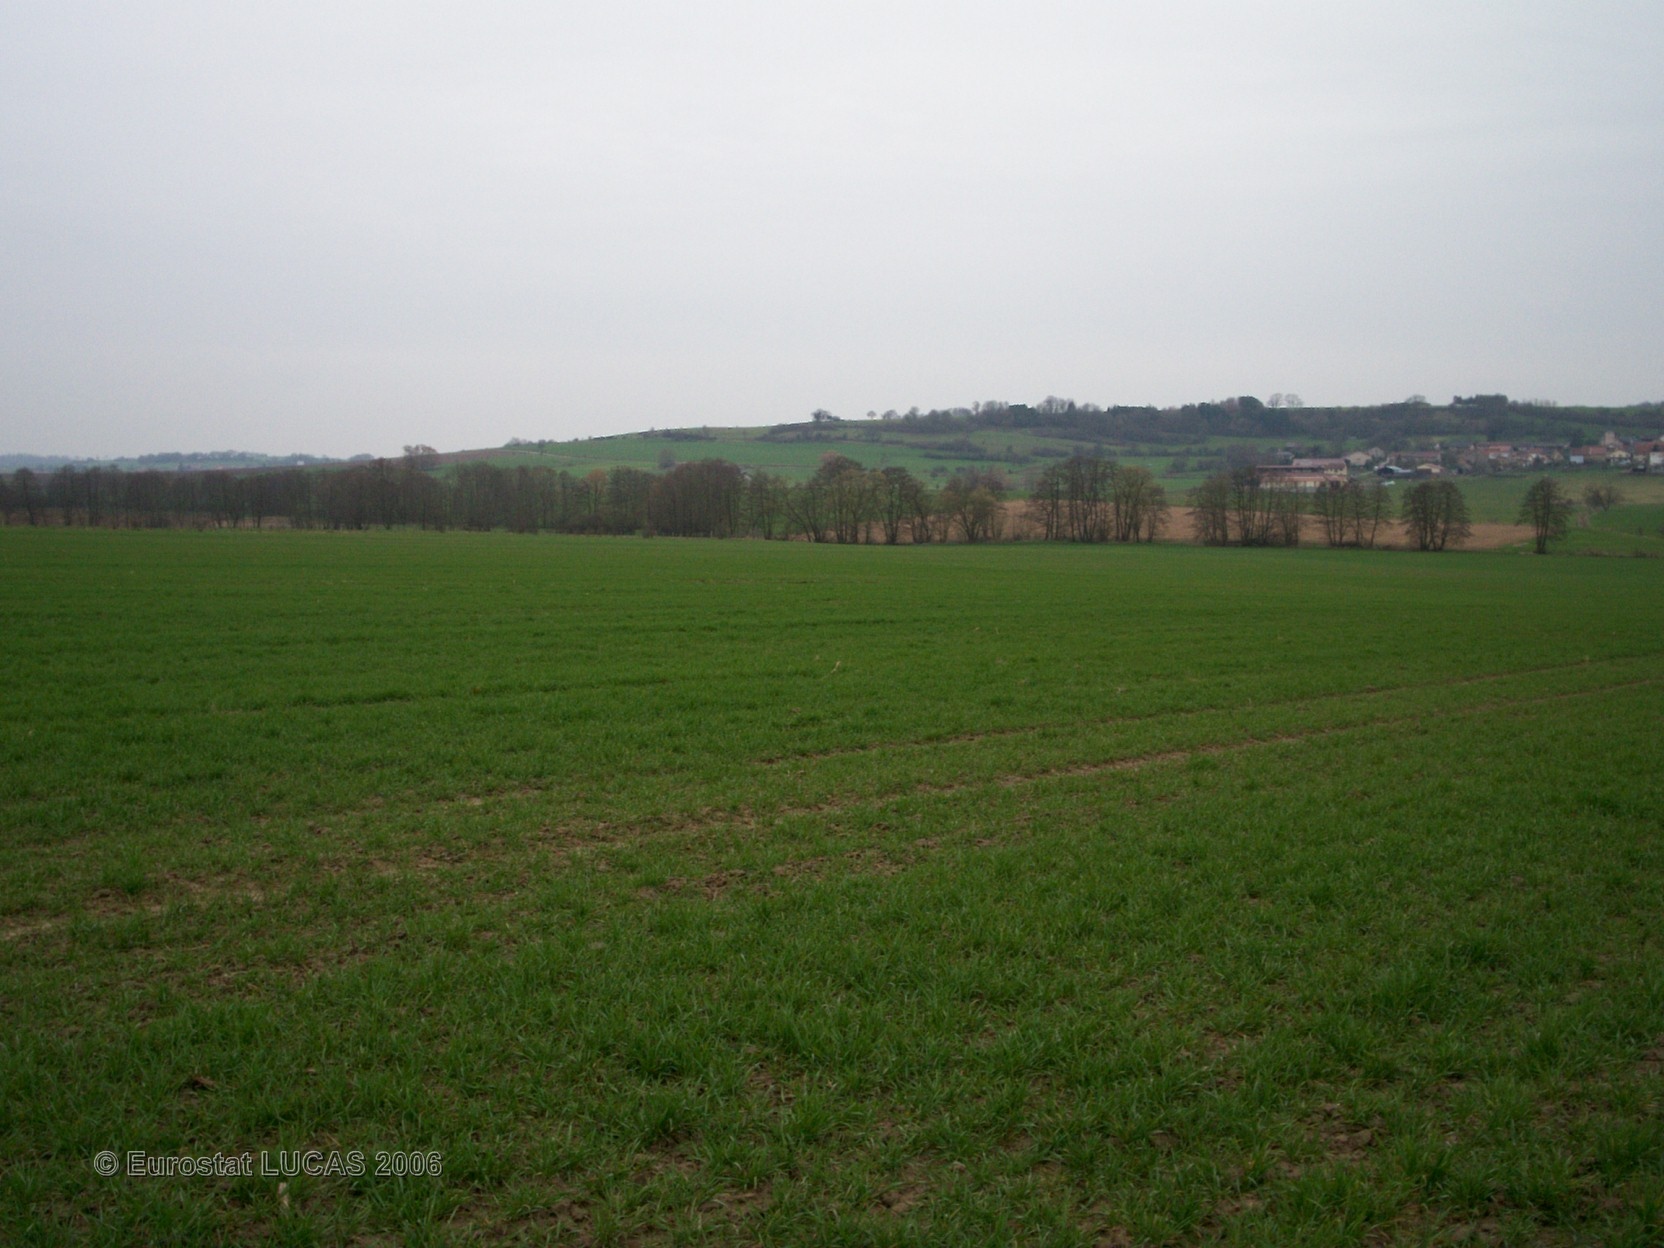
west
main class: Cropland
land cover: Common wheat
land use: Agriculture (excluding fallow land and kitchen gardens)
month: April
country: FR
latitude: 48.6329
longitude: 7.0018
